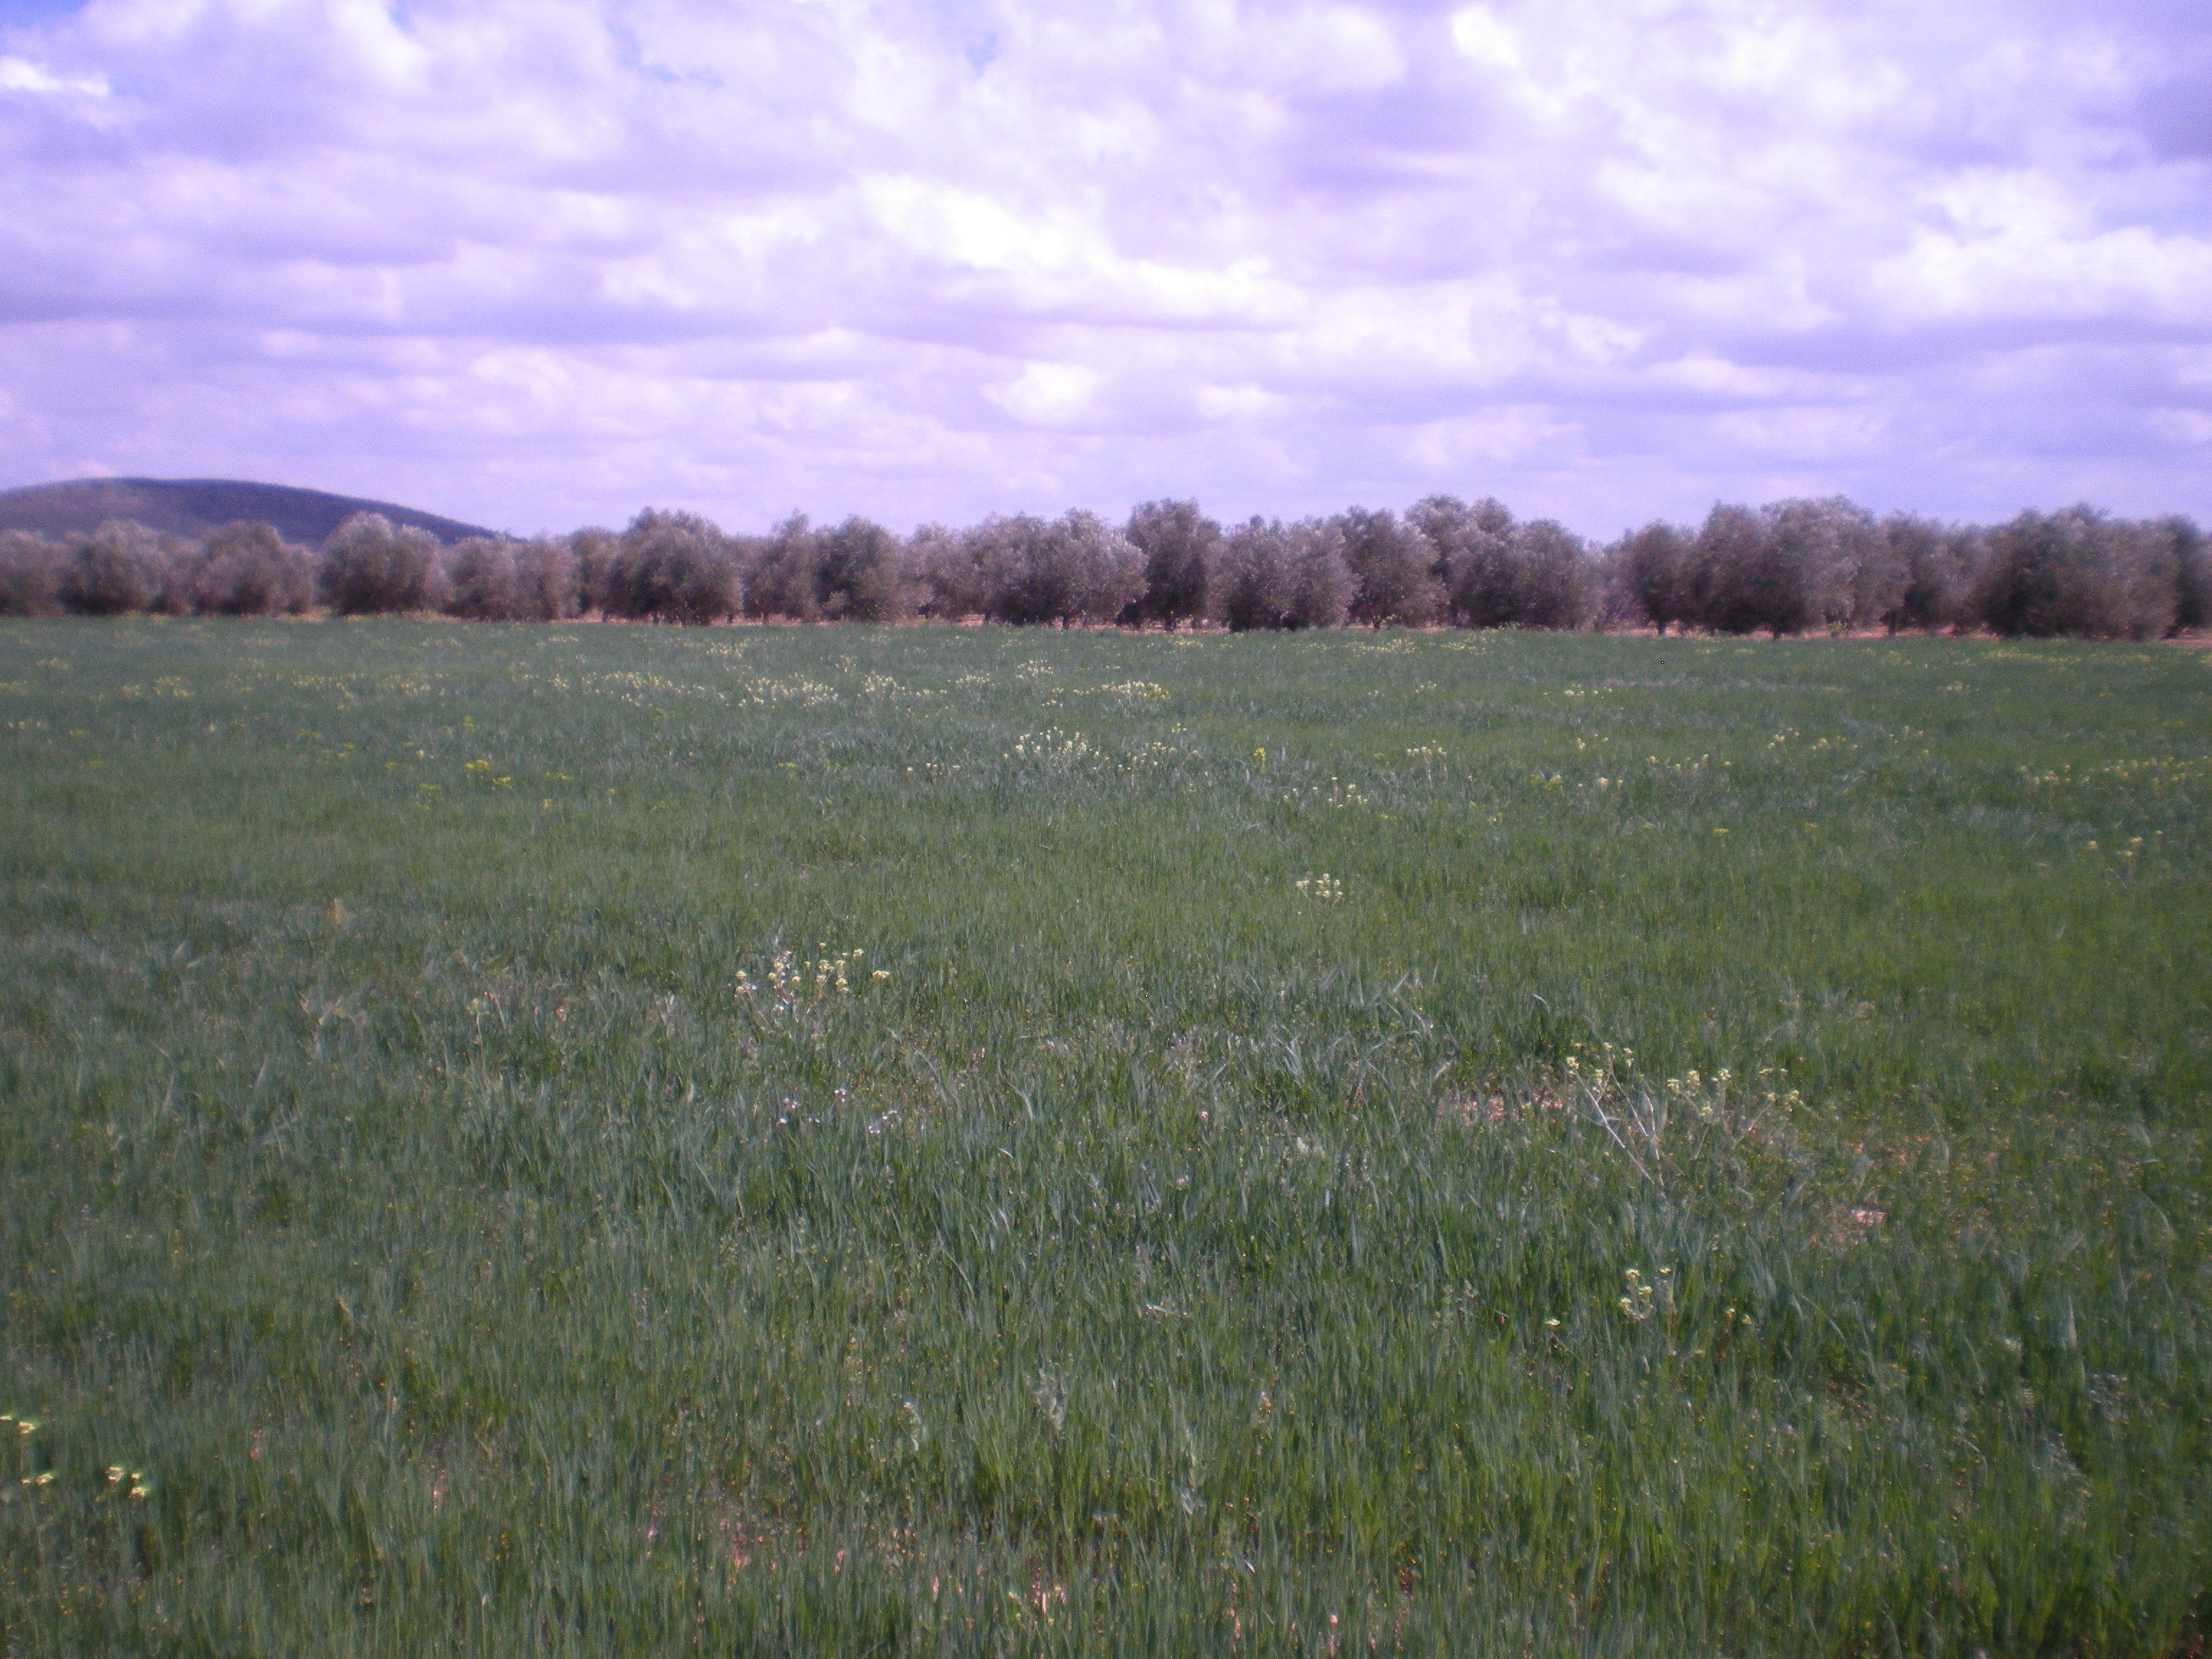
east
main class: Cropland
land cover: Oats
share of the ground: > 75 %
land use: Agriculture (excluding fallow land and kitchen gardens)
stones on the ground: 25 - 50 %
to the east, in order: Oats; Grass margins; Olive groves; Grass margins; Oats
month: April
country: ES
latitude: 38.7033
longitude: -3.5227
